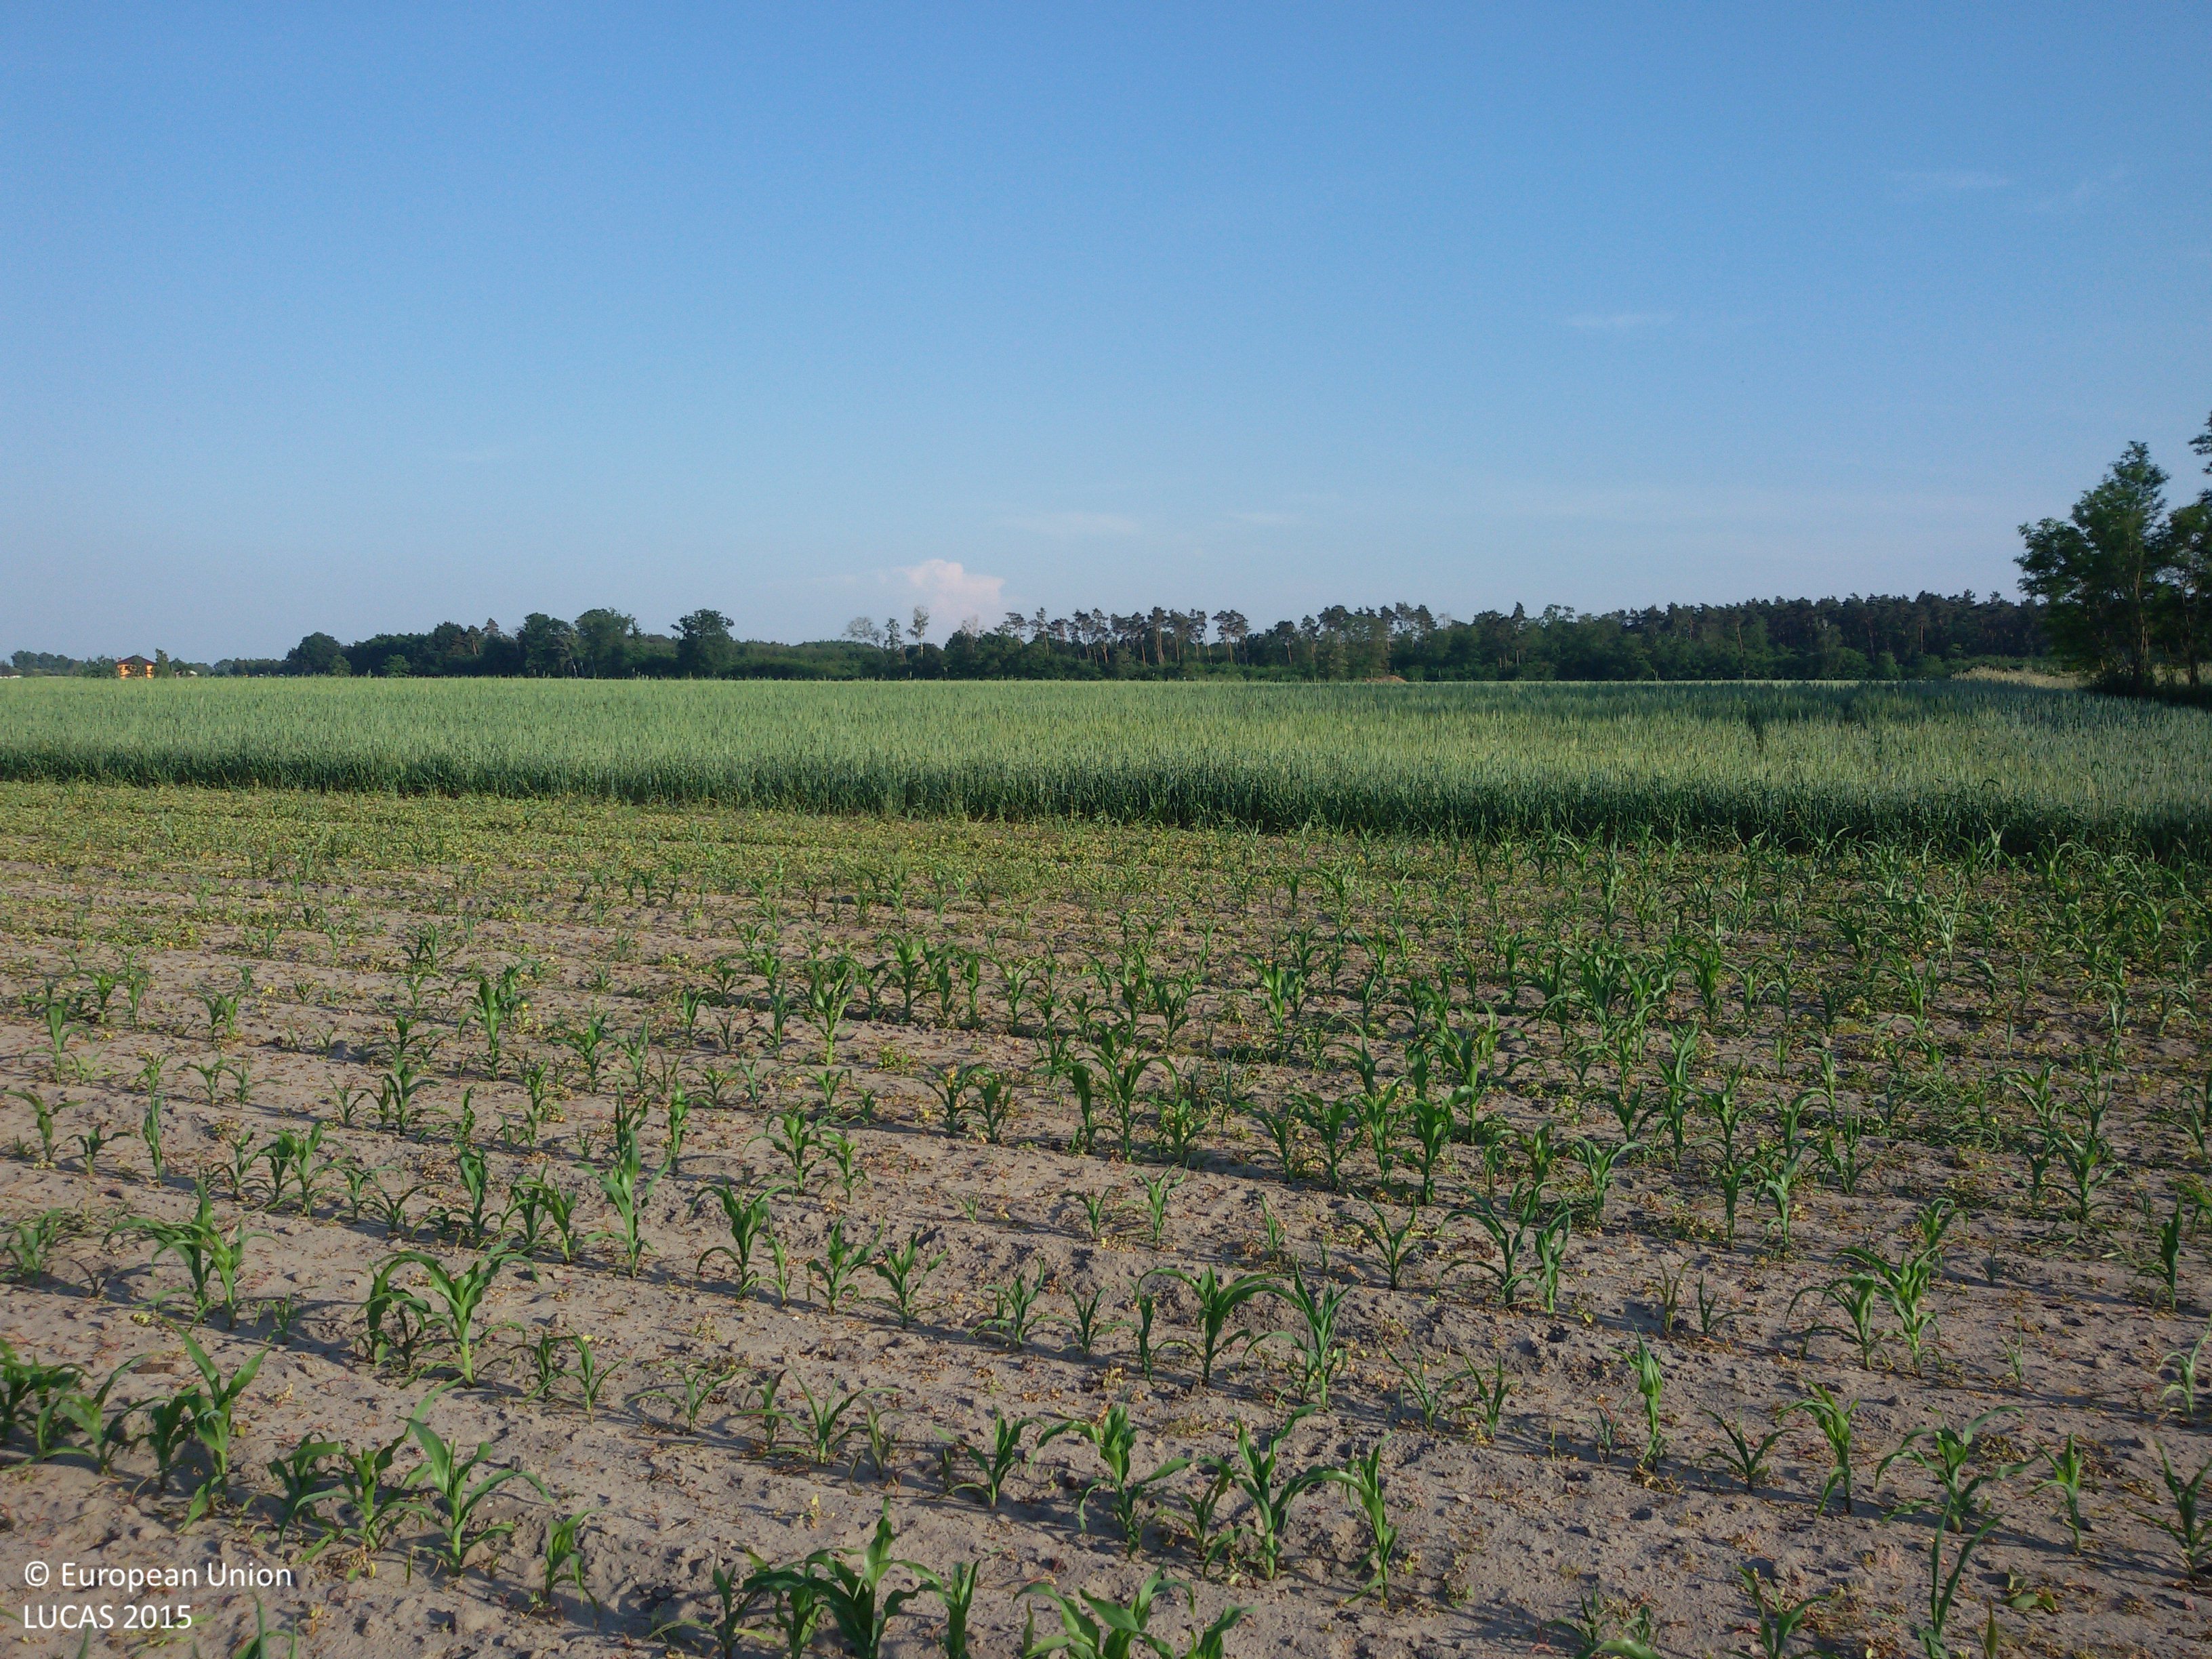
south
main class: Cropland
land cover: Maize
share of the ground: 25 - 50 %
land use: Agriculture (excluding fallow land and kitchen gardens)
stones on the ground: < 10 %
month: June
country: PL
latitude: 52.5036
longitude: 19.0245
